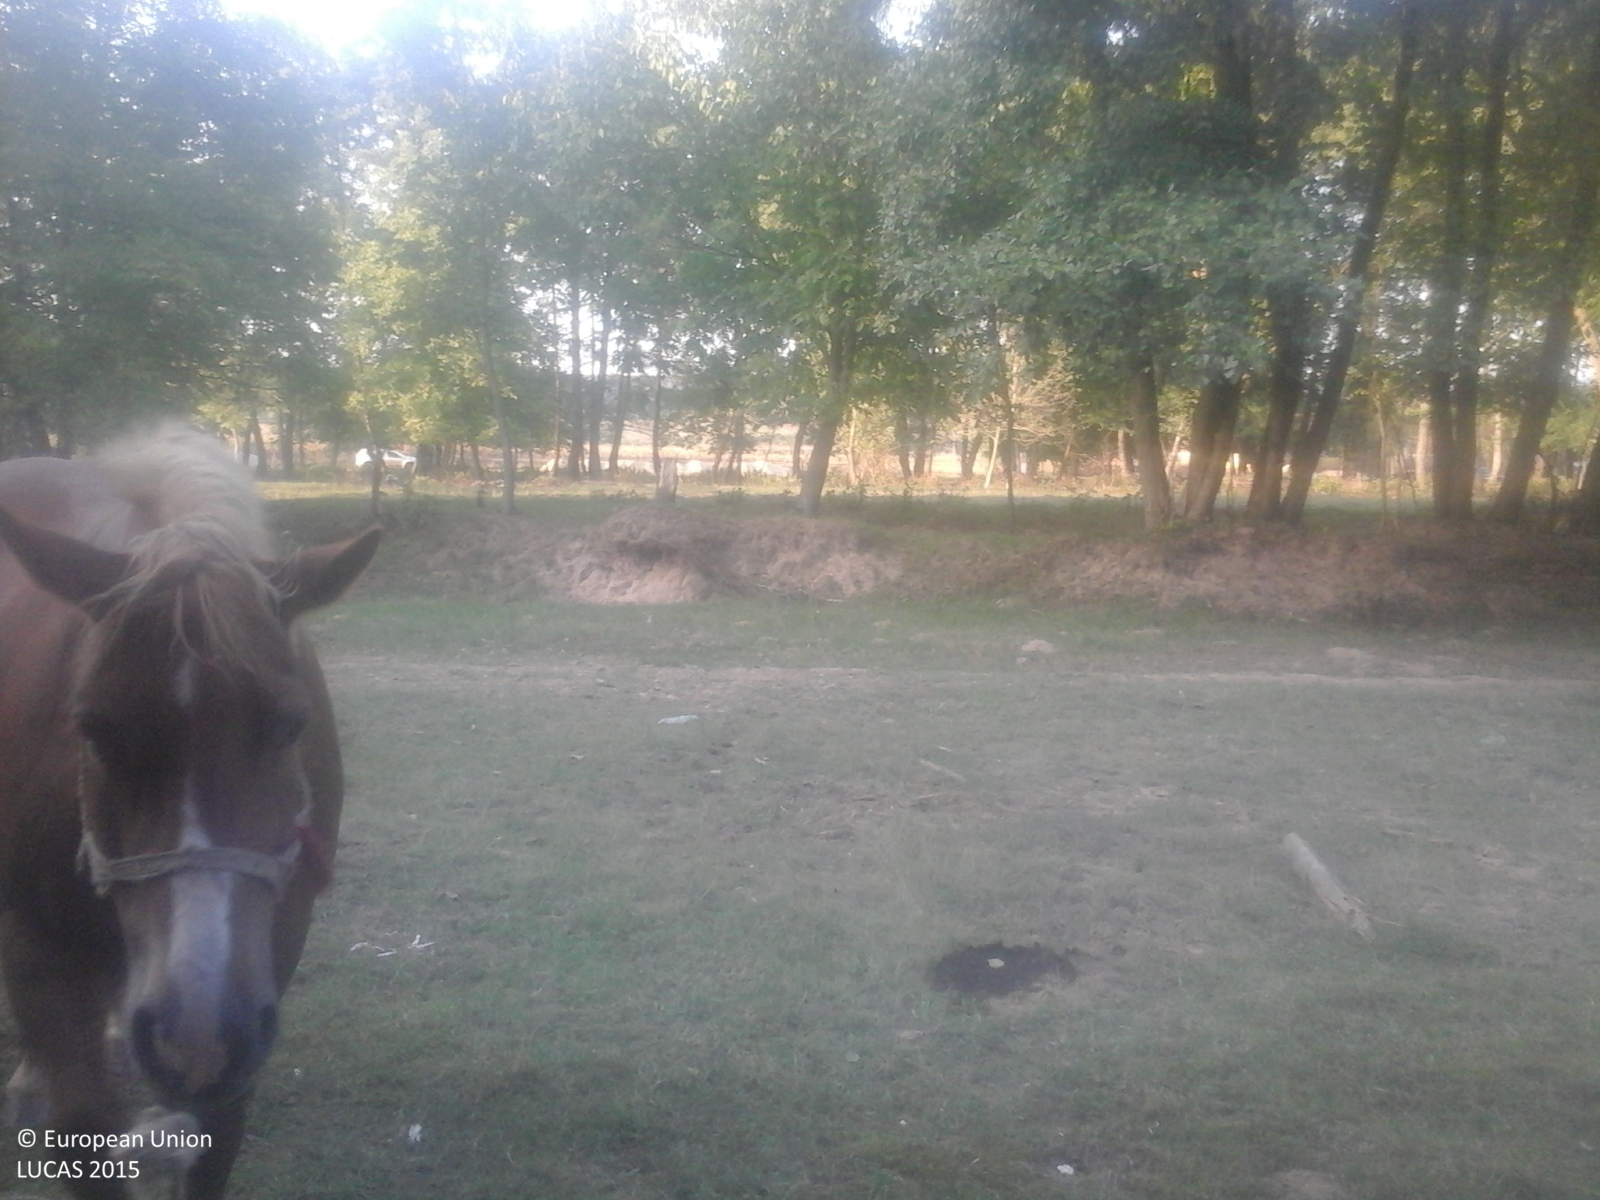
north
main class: Grassland
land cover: Grassland without tree/shrub cover
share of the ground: > 75 %
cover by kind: herbaceous plants 100 %
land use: Agriculture (excluding fallow land and kitchen gardens)
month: September
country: RO
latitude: 46.6259
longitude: 22.4192
